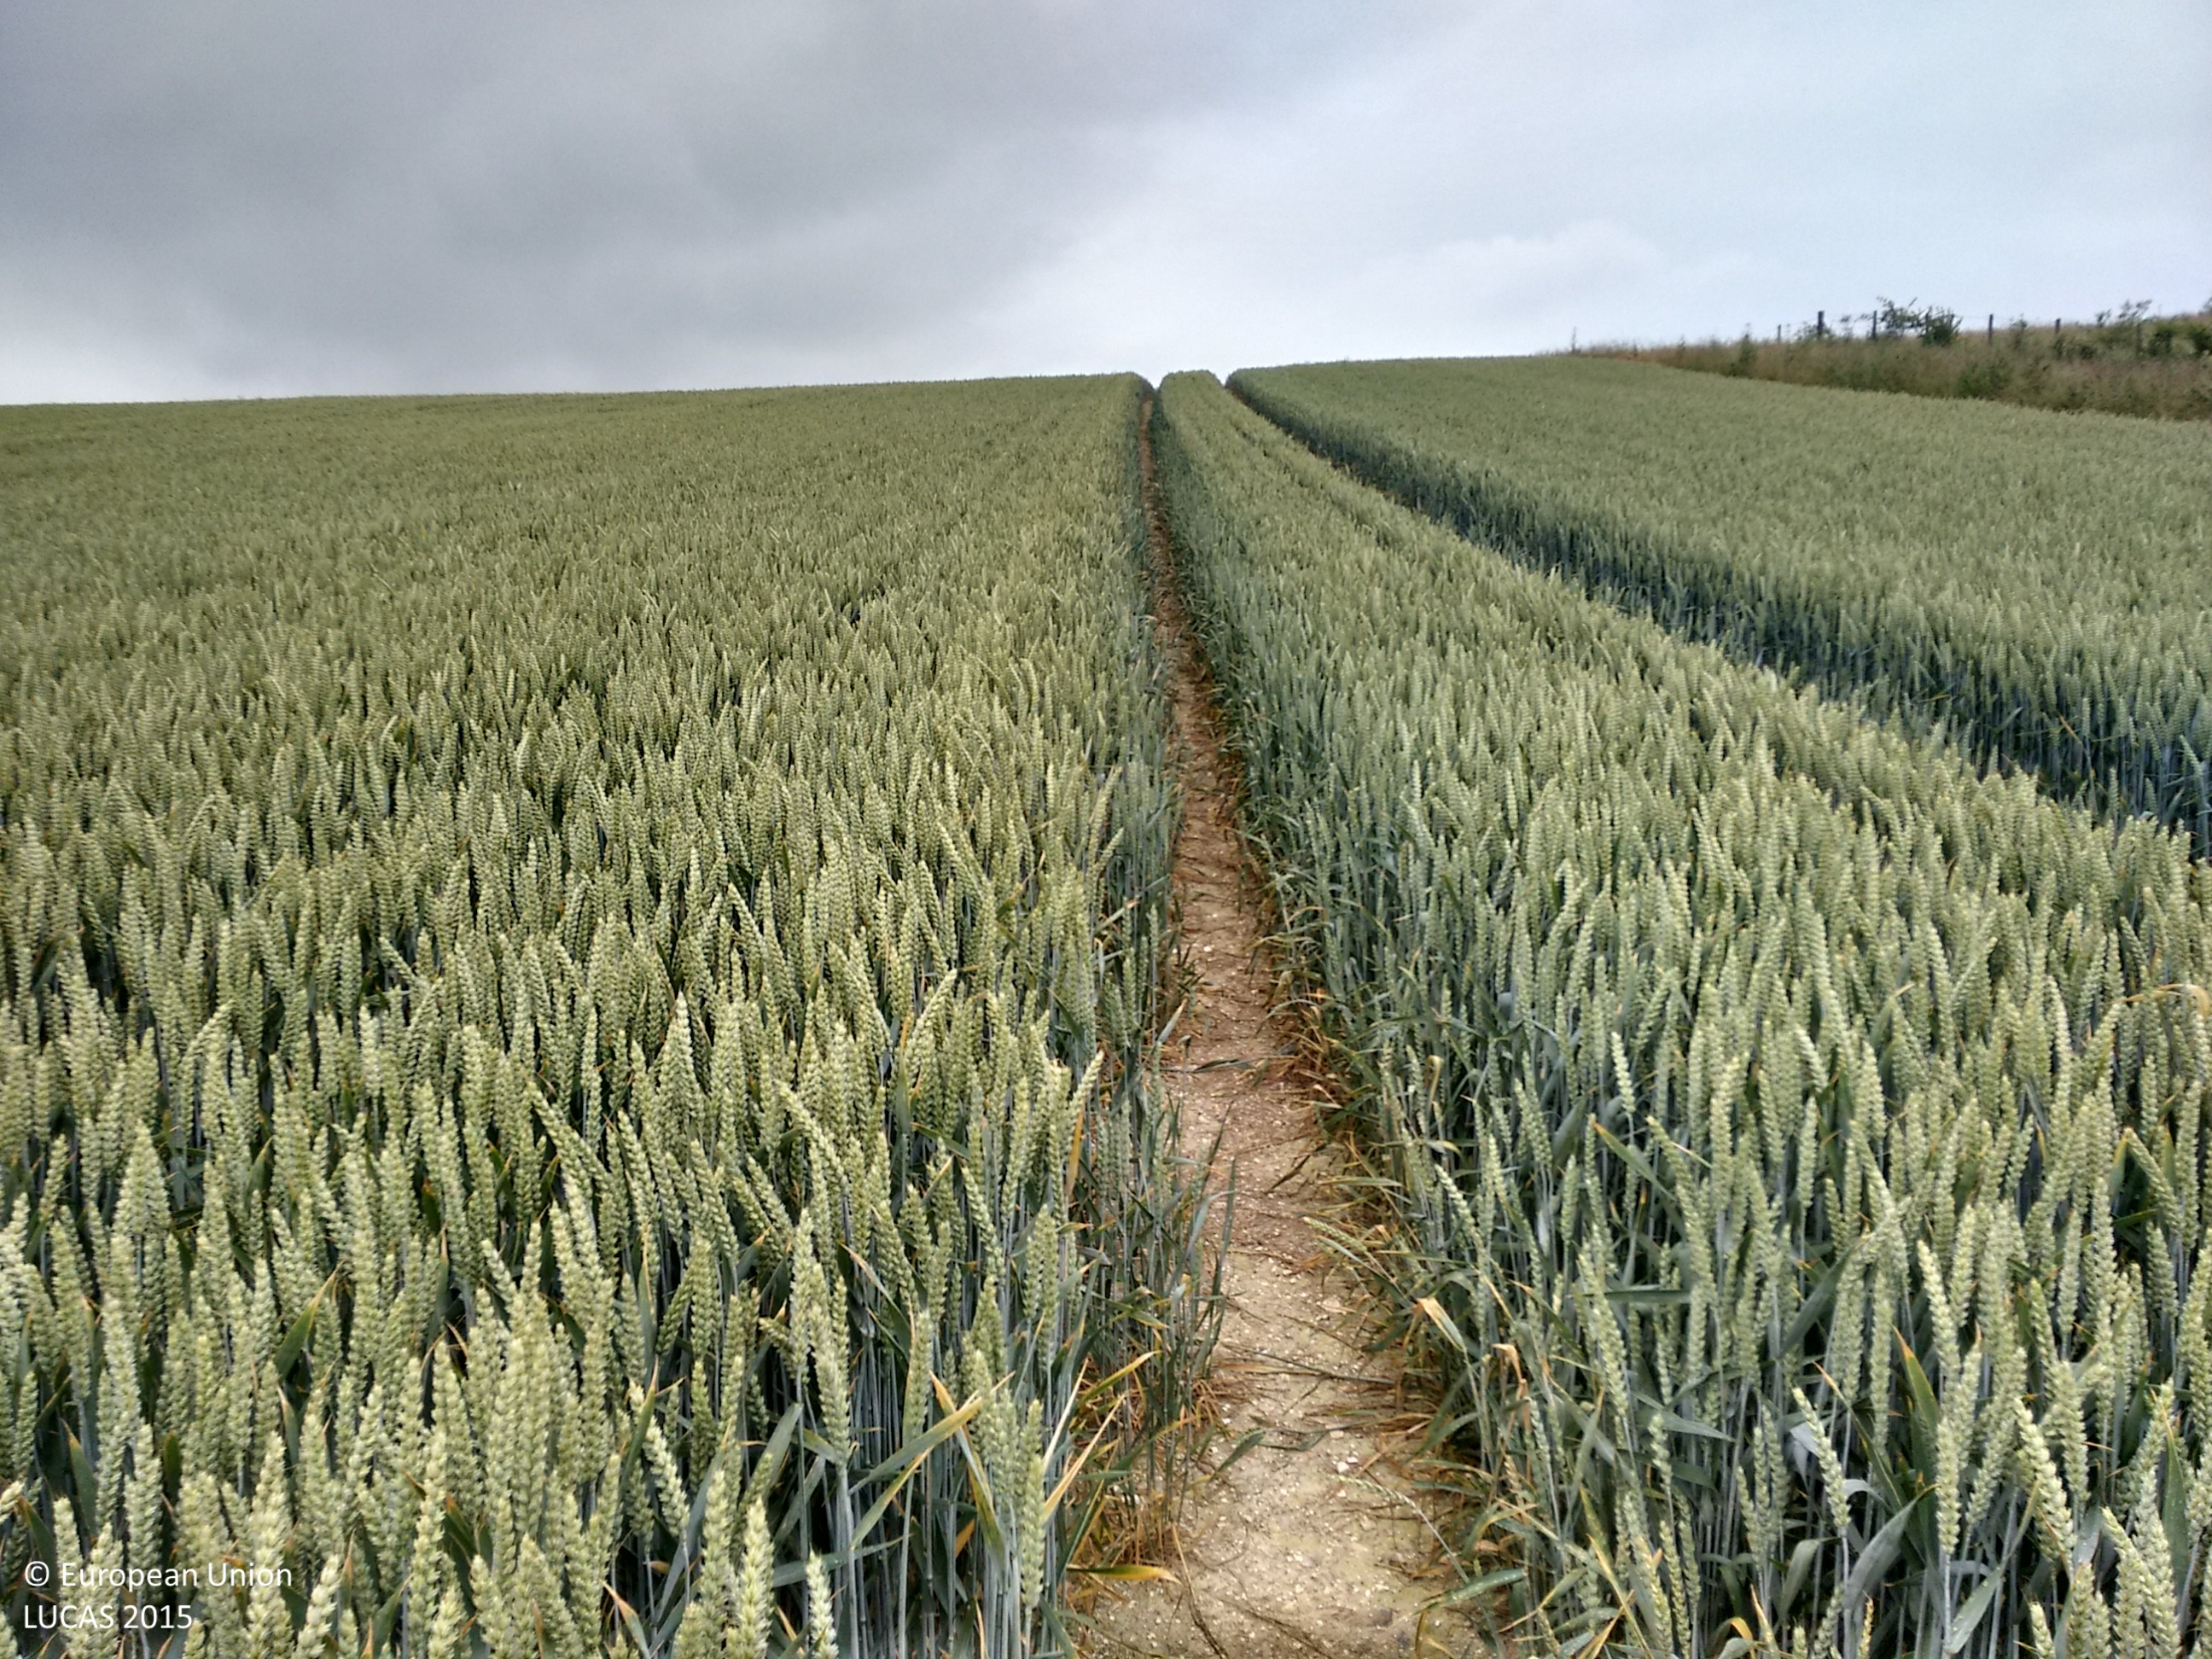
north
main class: Cropland
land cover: Common wheat
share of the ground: > 75 %
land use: Agriculture (excluding fallow land and kitchen gardens)
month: July
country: GB
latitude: 51.5487
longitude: -1.0775
